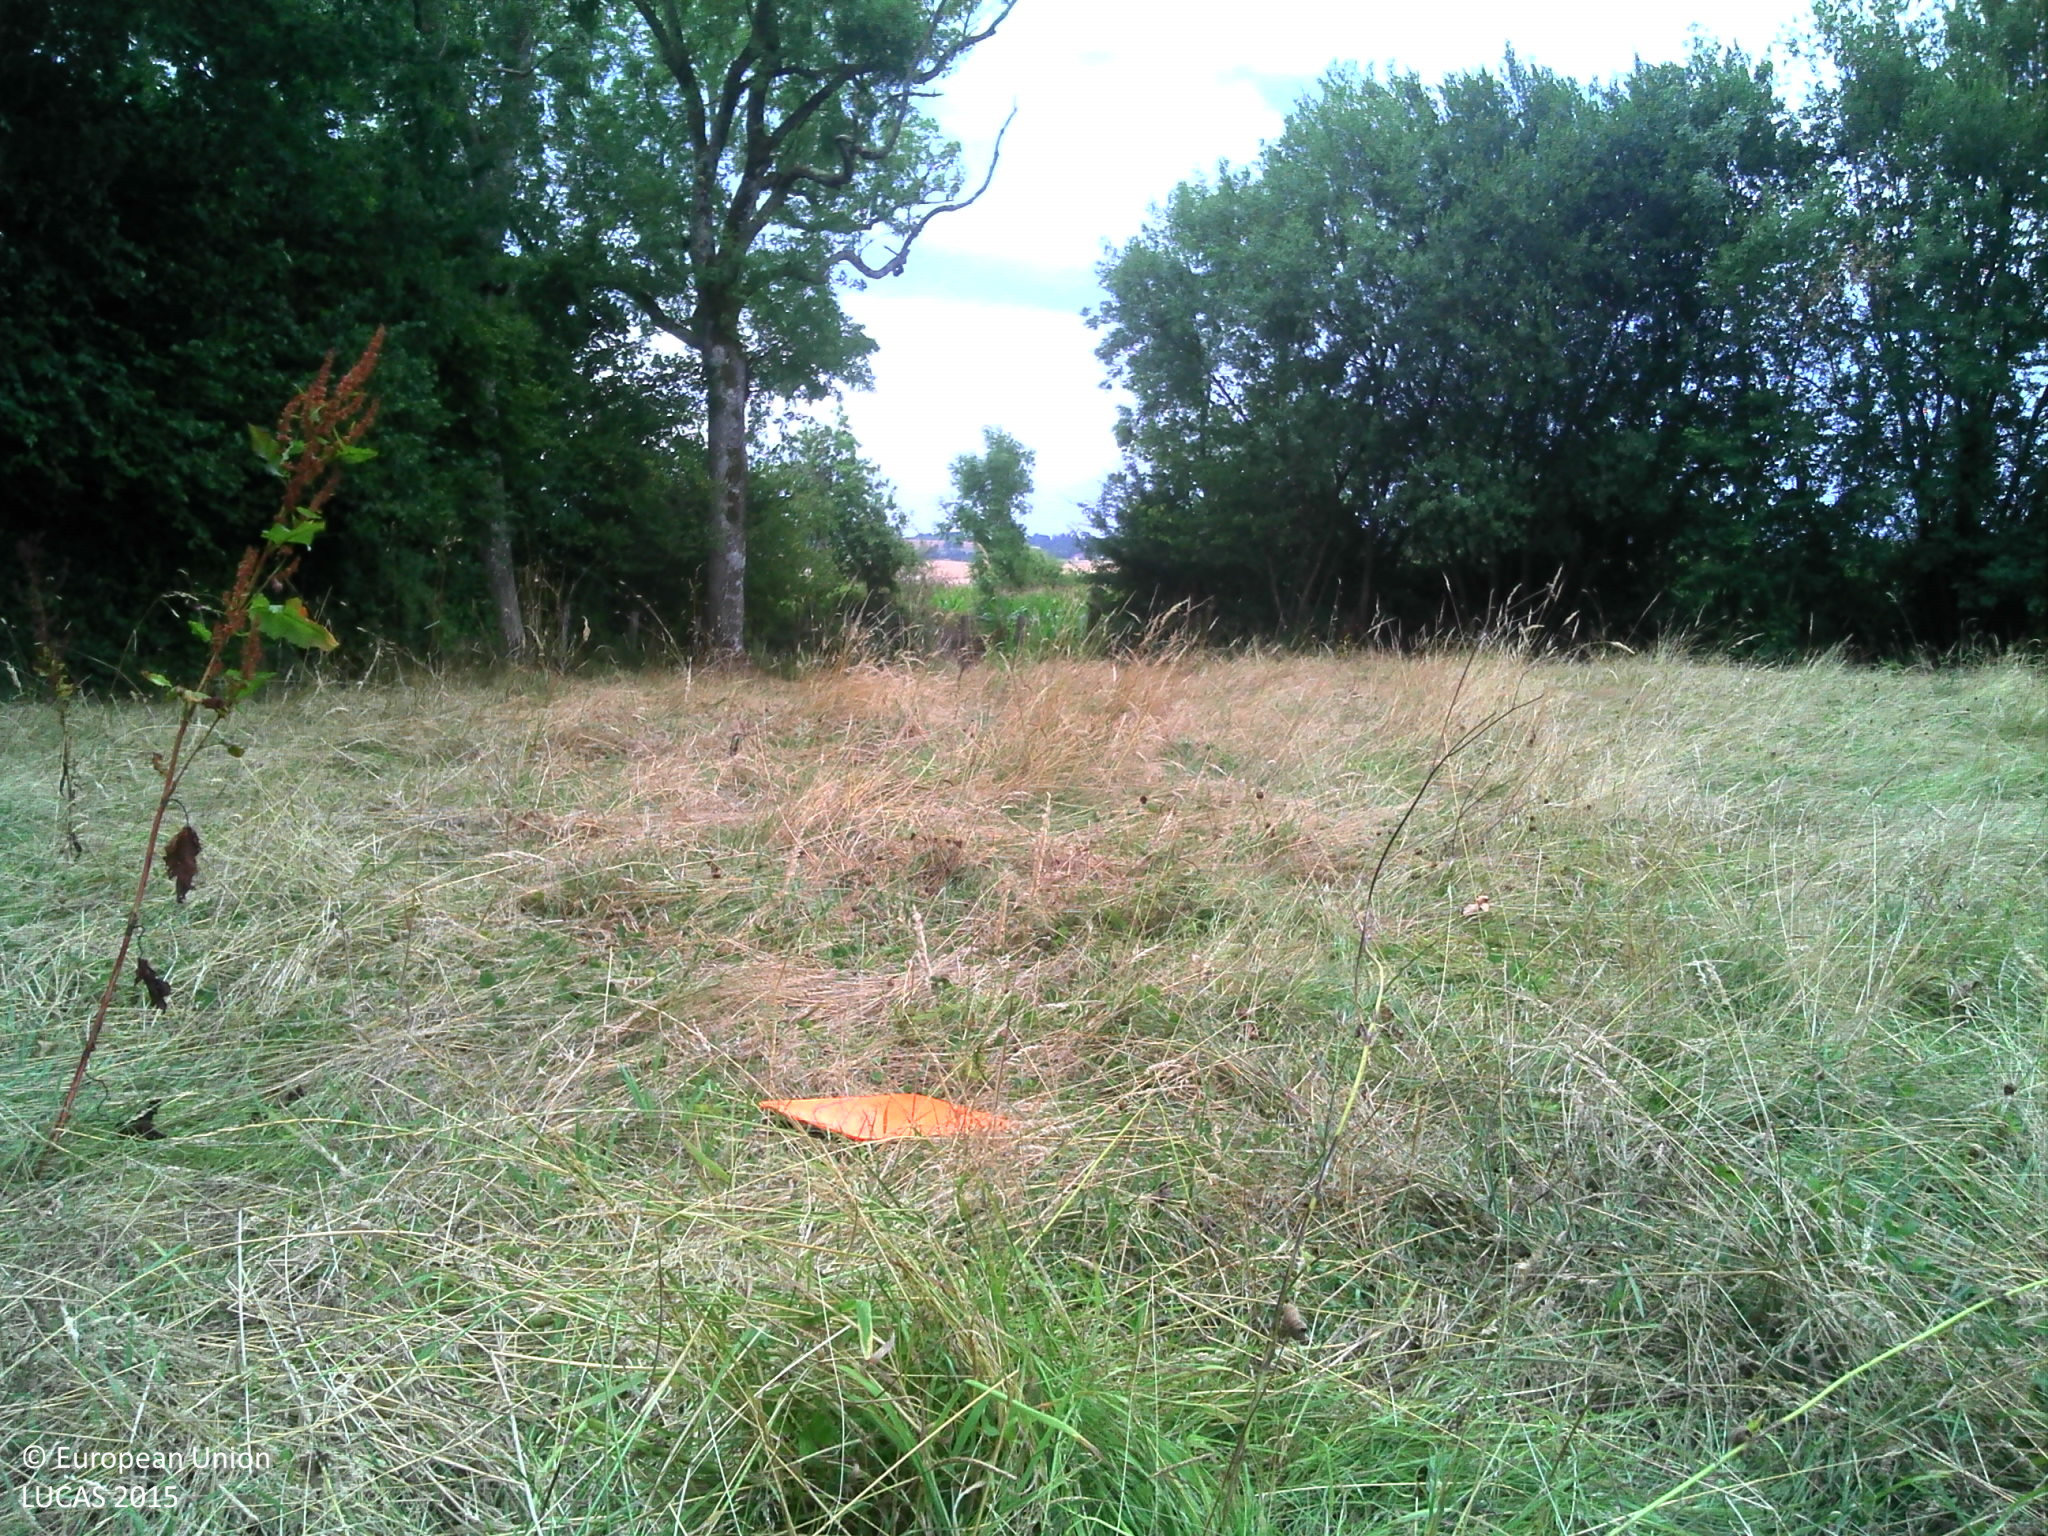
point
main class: Grassland
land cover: Grassland without tree/shrub cover
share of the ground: > 75 %
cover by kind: herbaceous plants 100 %
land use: Agriculture (excluding fallow land and kitchen gardens)
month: July
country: FR
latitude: 48.5757
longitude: 0.5282
